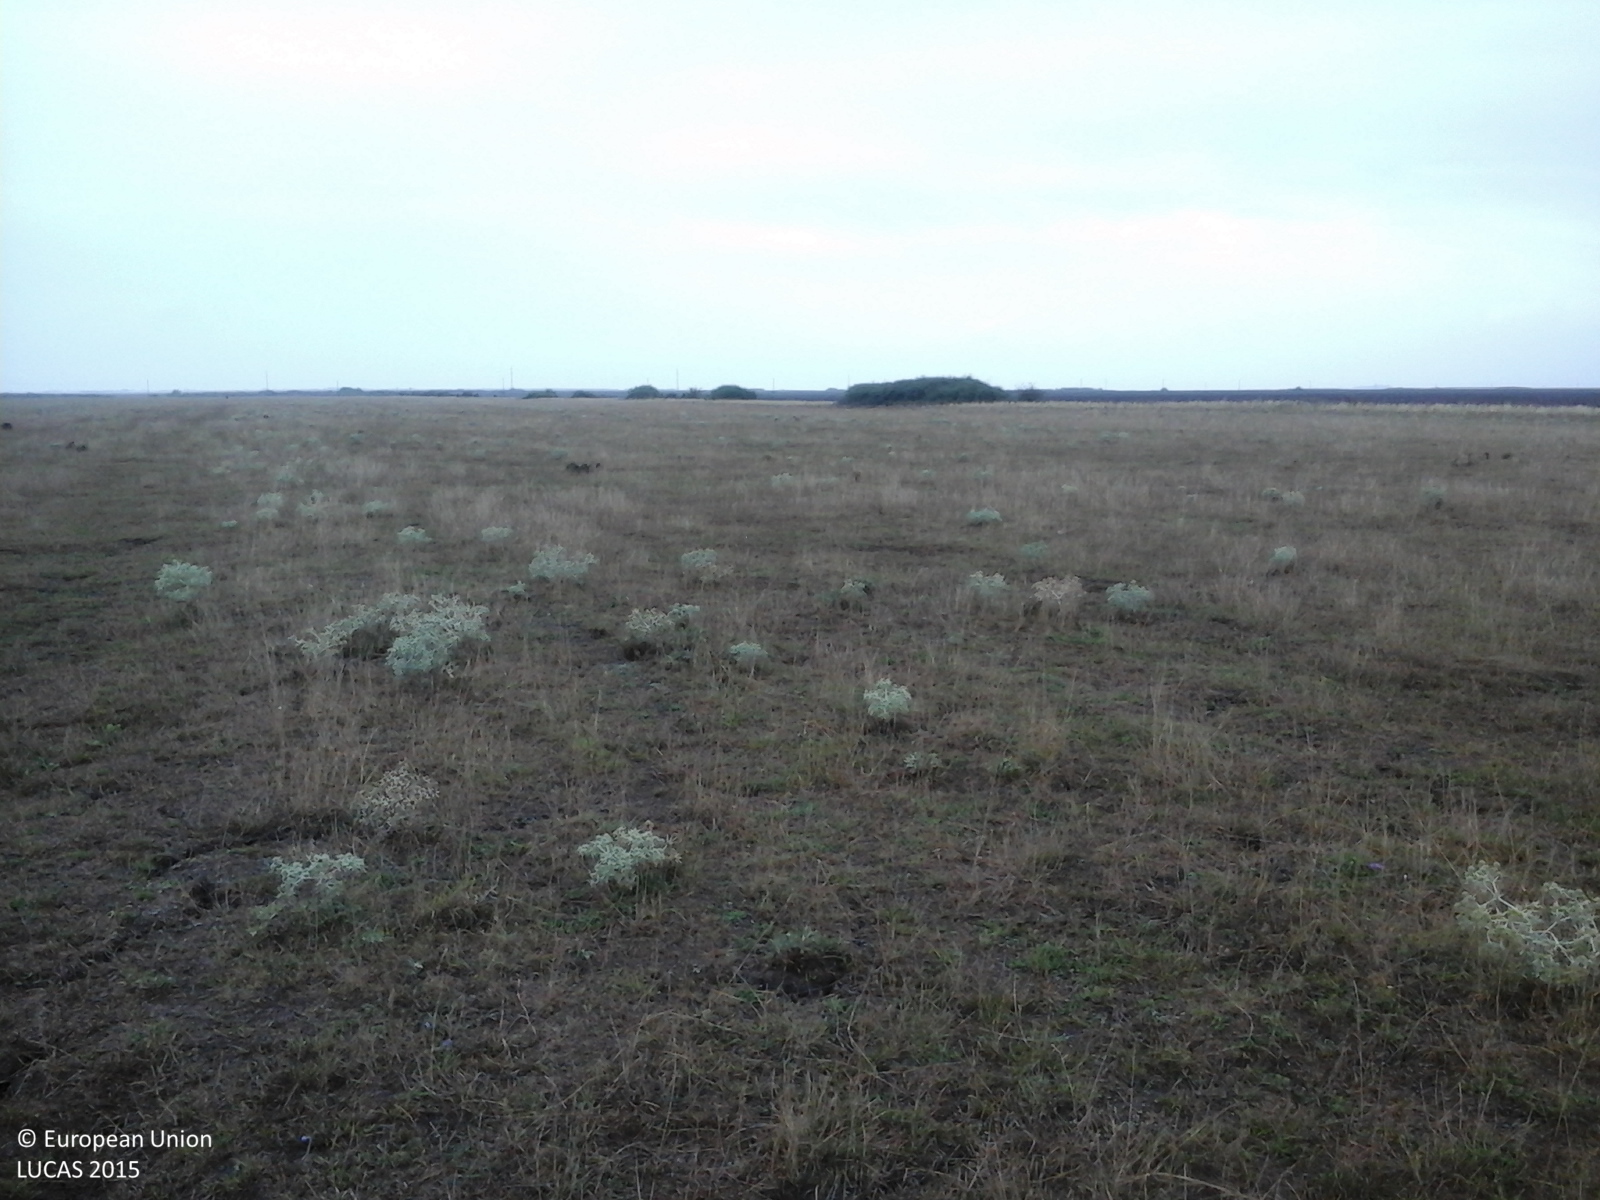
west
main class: Grassland
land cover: Spontaneously vegetated surfaces
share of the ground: > 75 %
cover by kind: herbaceous plants 100 %
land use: Fallow land
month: August
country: RO
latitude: 45.4639
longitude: 21.4266
